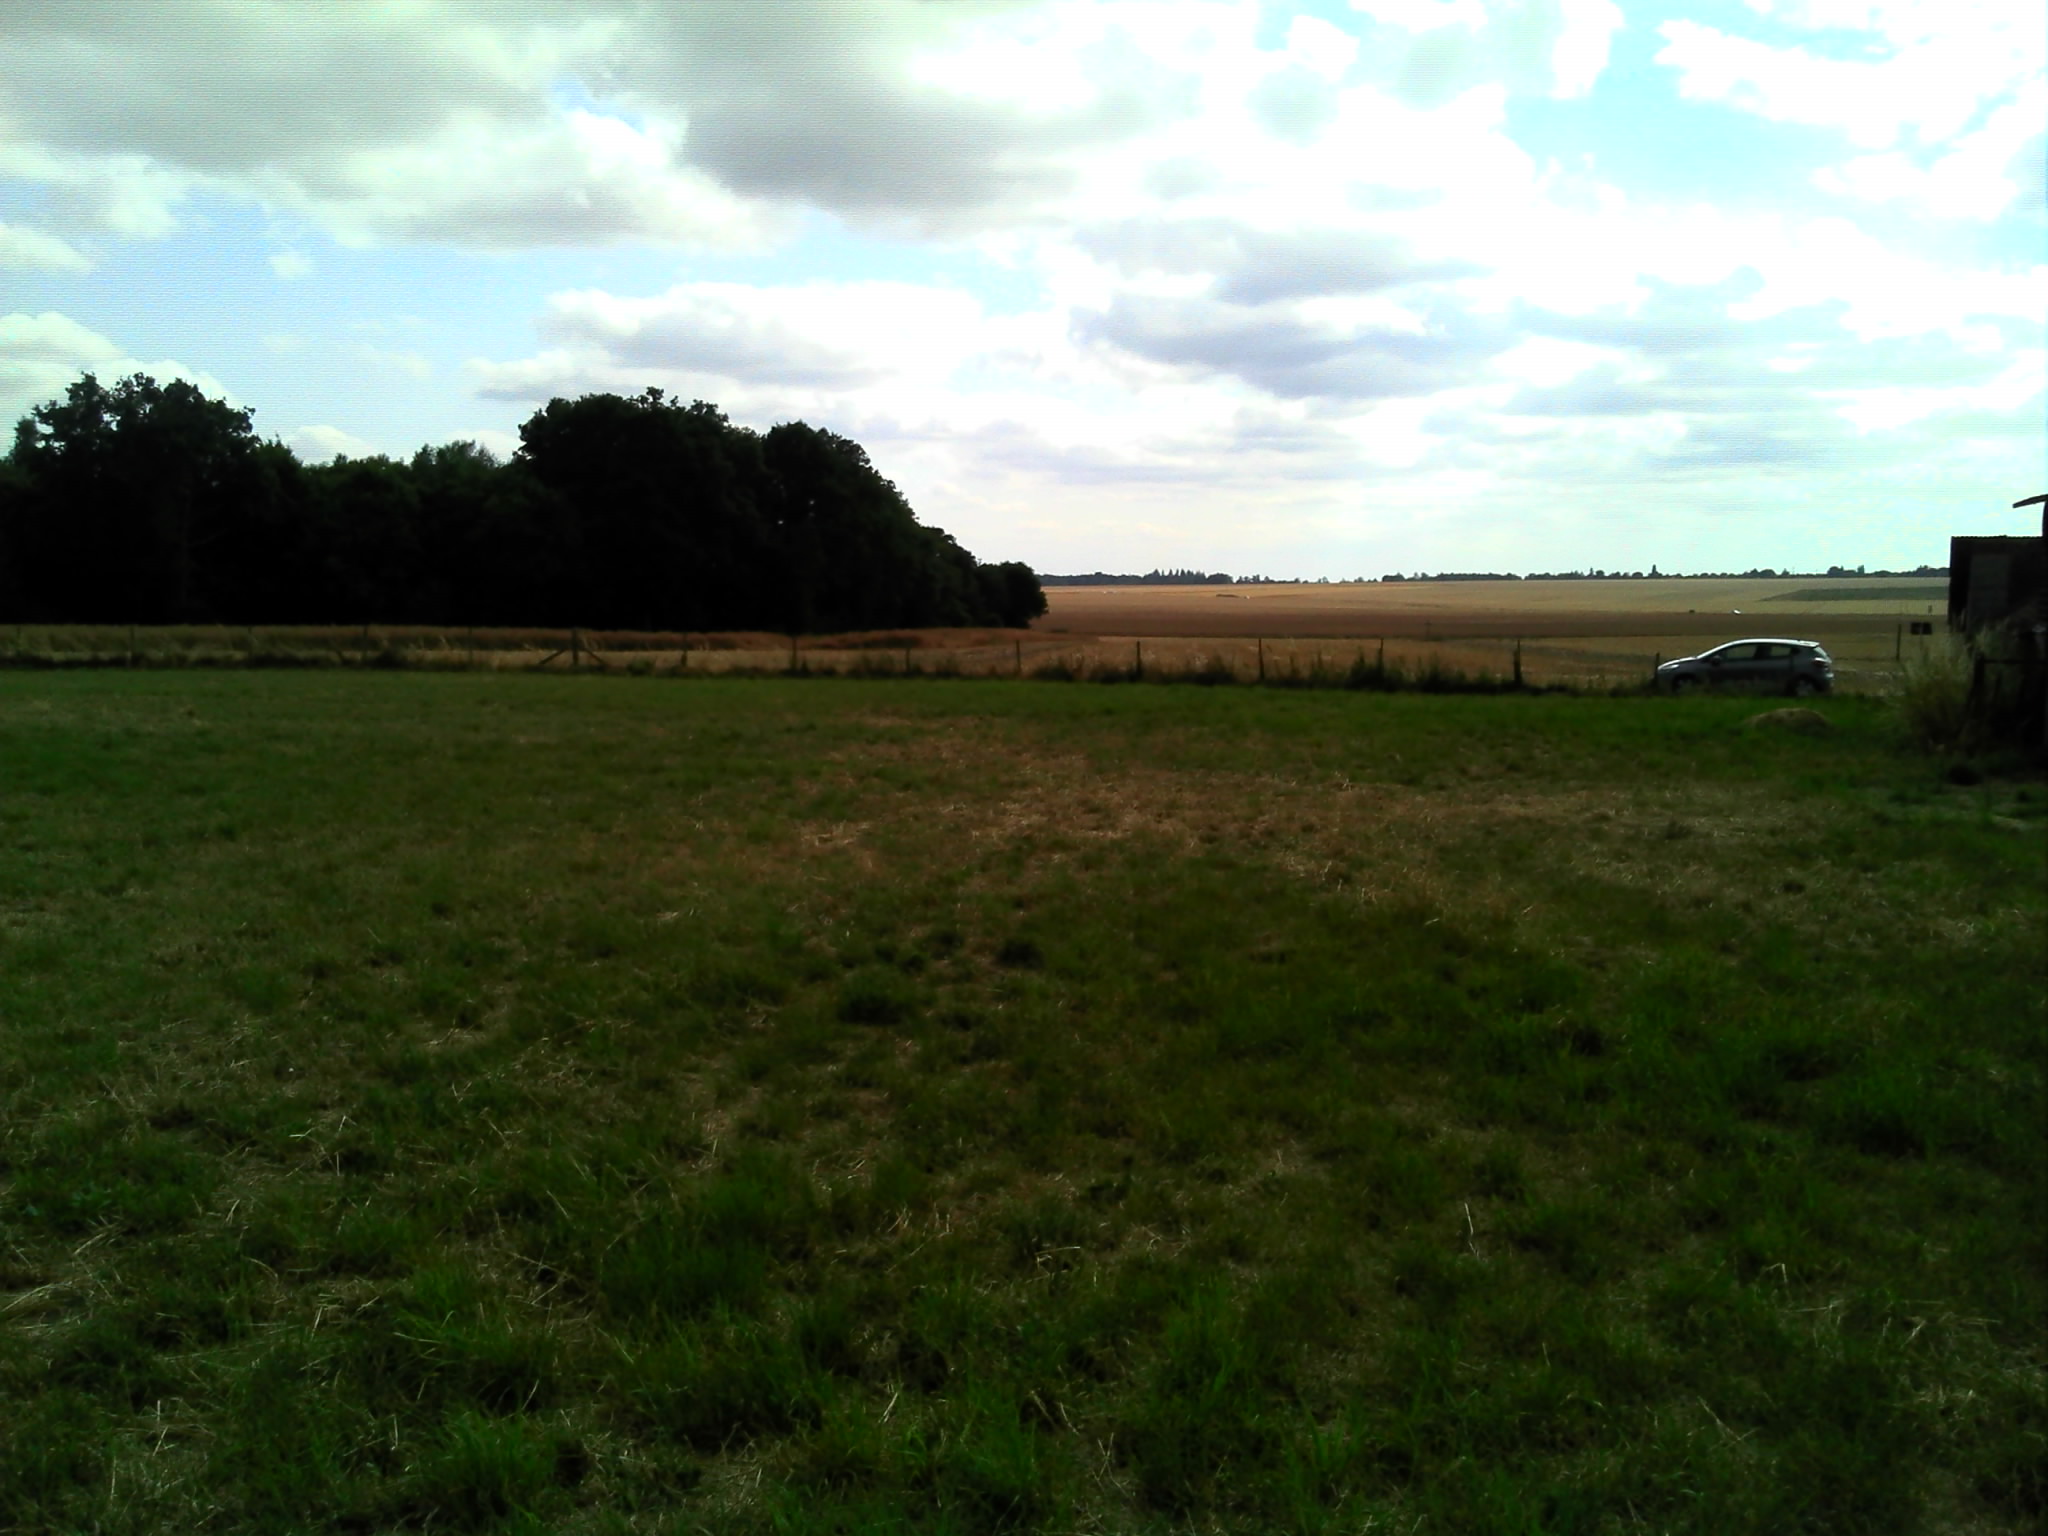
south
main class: Grassland
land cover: Grassland without tree/shrub cover
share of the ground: > 75 %
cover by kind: herbaceous plants 100 %
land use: Agriculture (excluding fallow land and kitchen gardens)
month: July
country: FR
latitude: 48.9325
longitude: 1.1204
